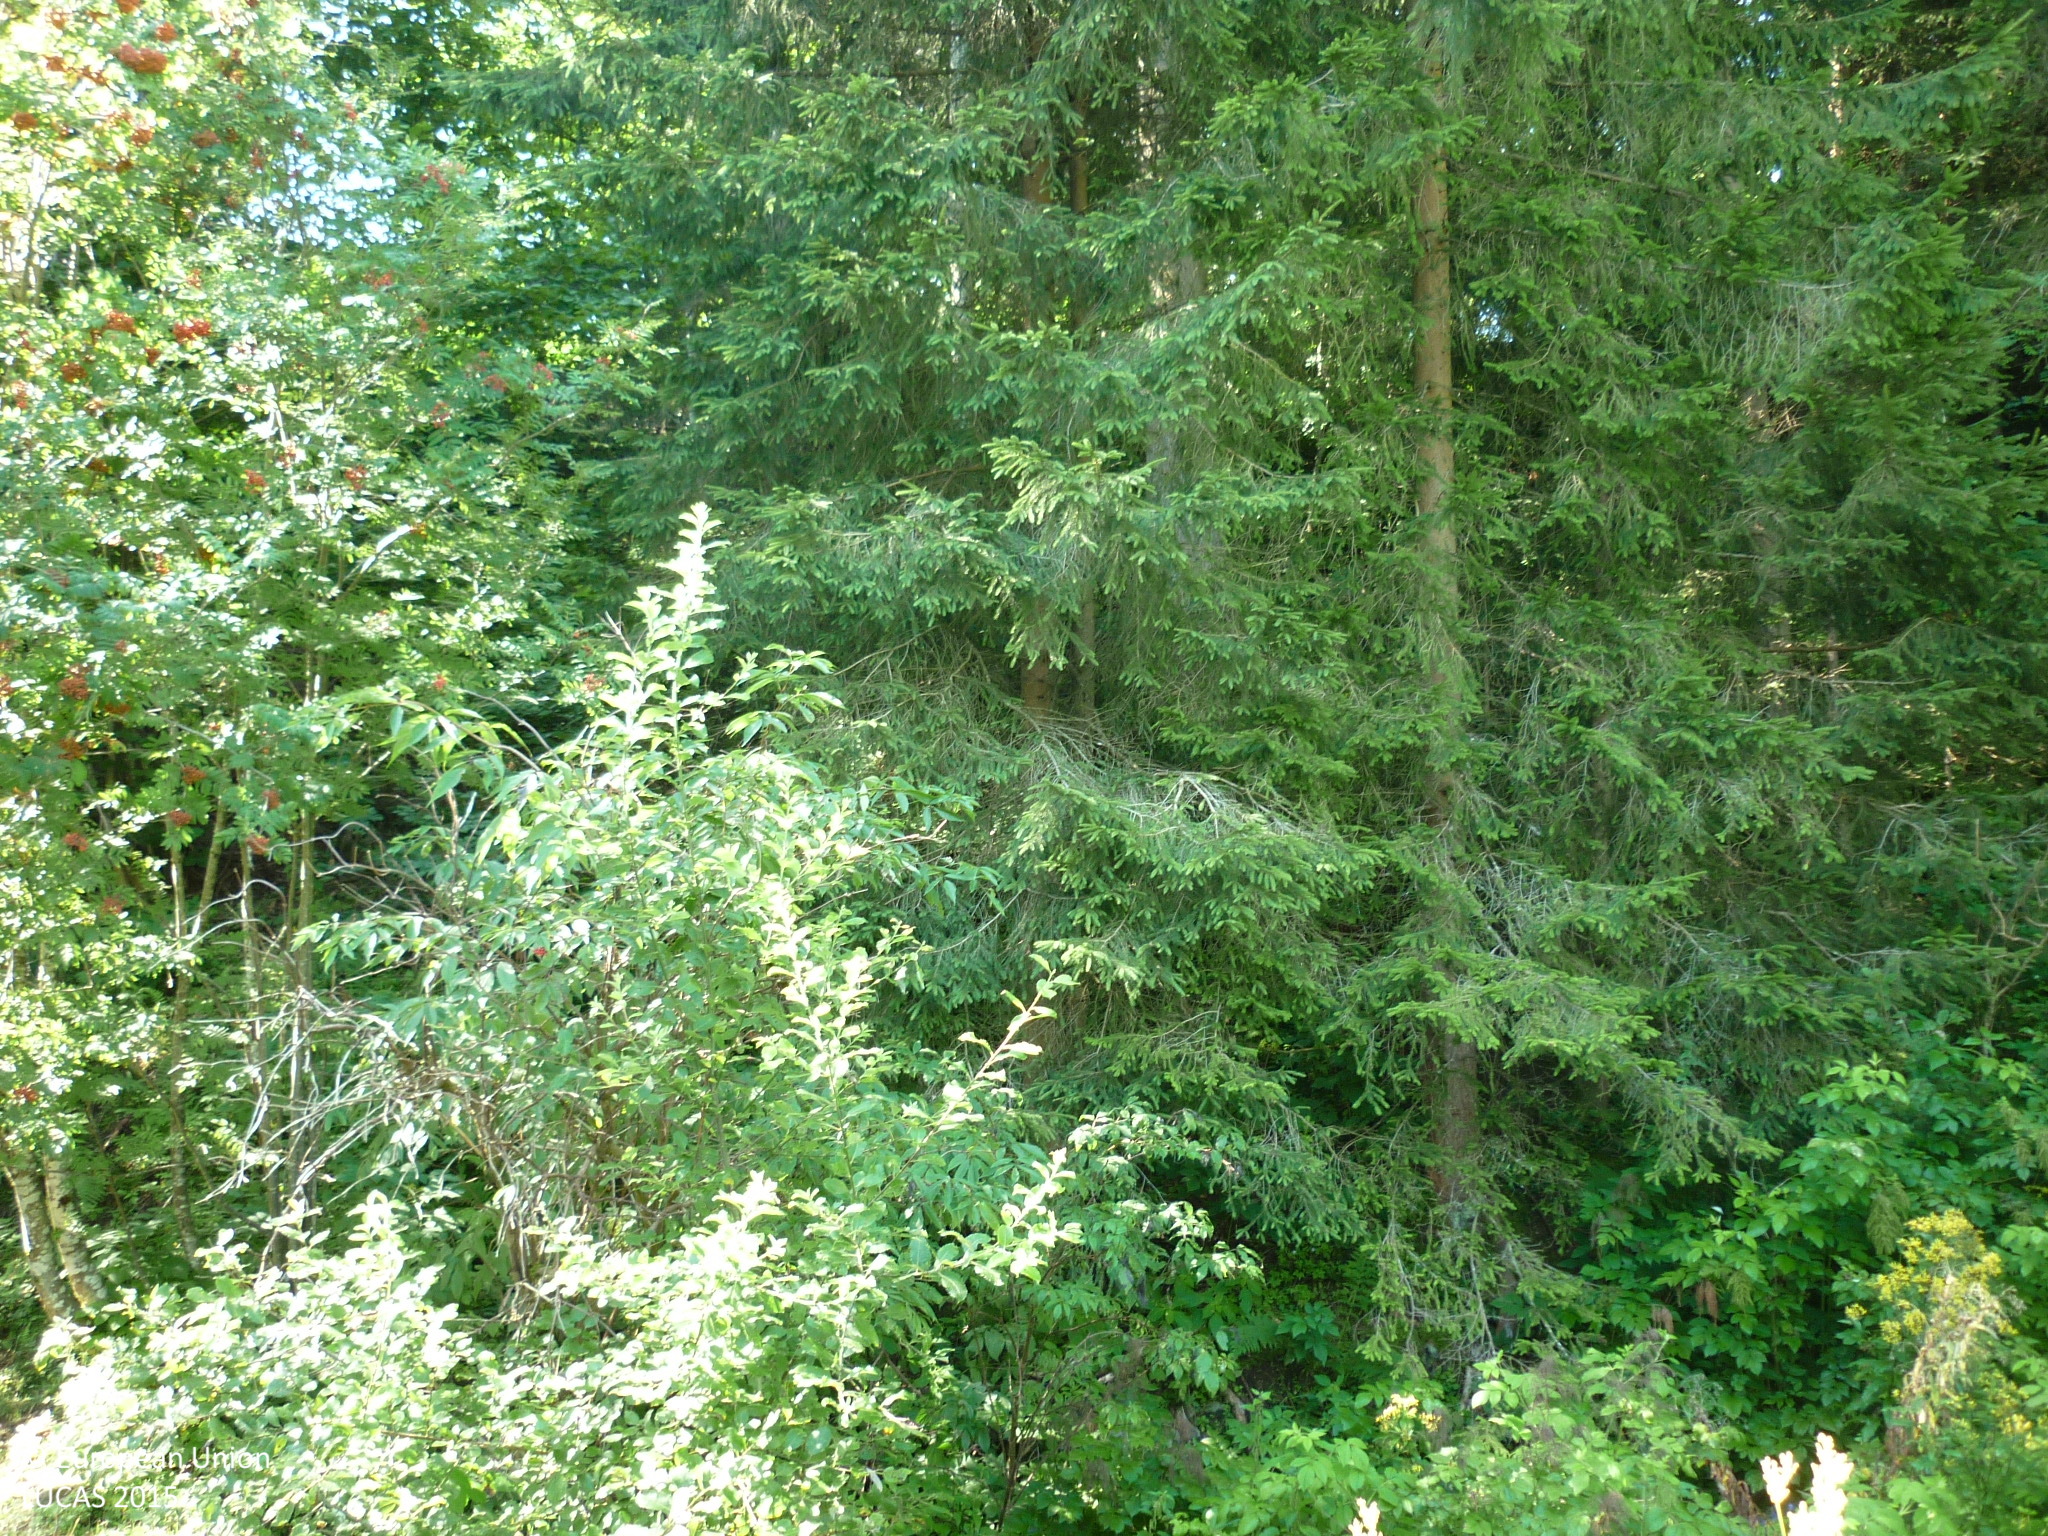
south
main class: Grassland
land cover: Grassland without tree/shrub cover
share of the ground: > 75 %
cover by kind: herbaceous plants 100 %
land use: Agriculture (excluding fallow land and kitchen gardens)
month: August
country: AT
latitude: 46.9042
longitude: 13.5815
